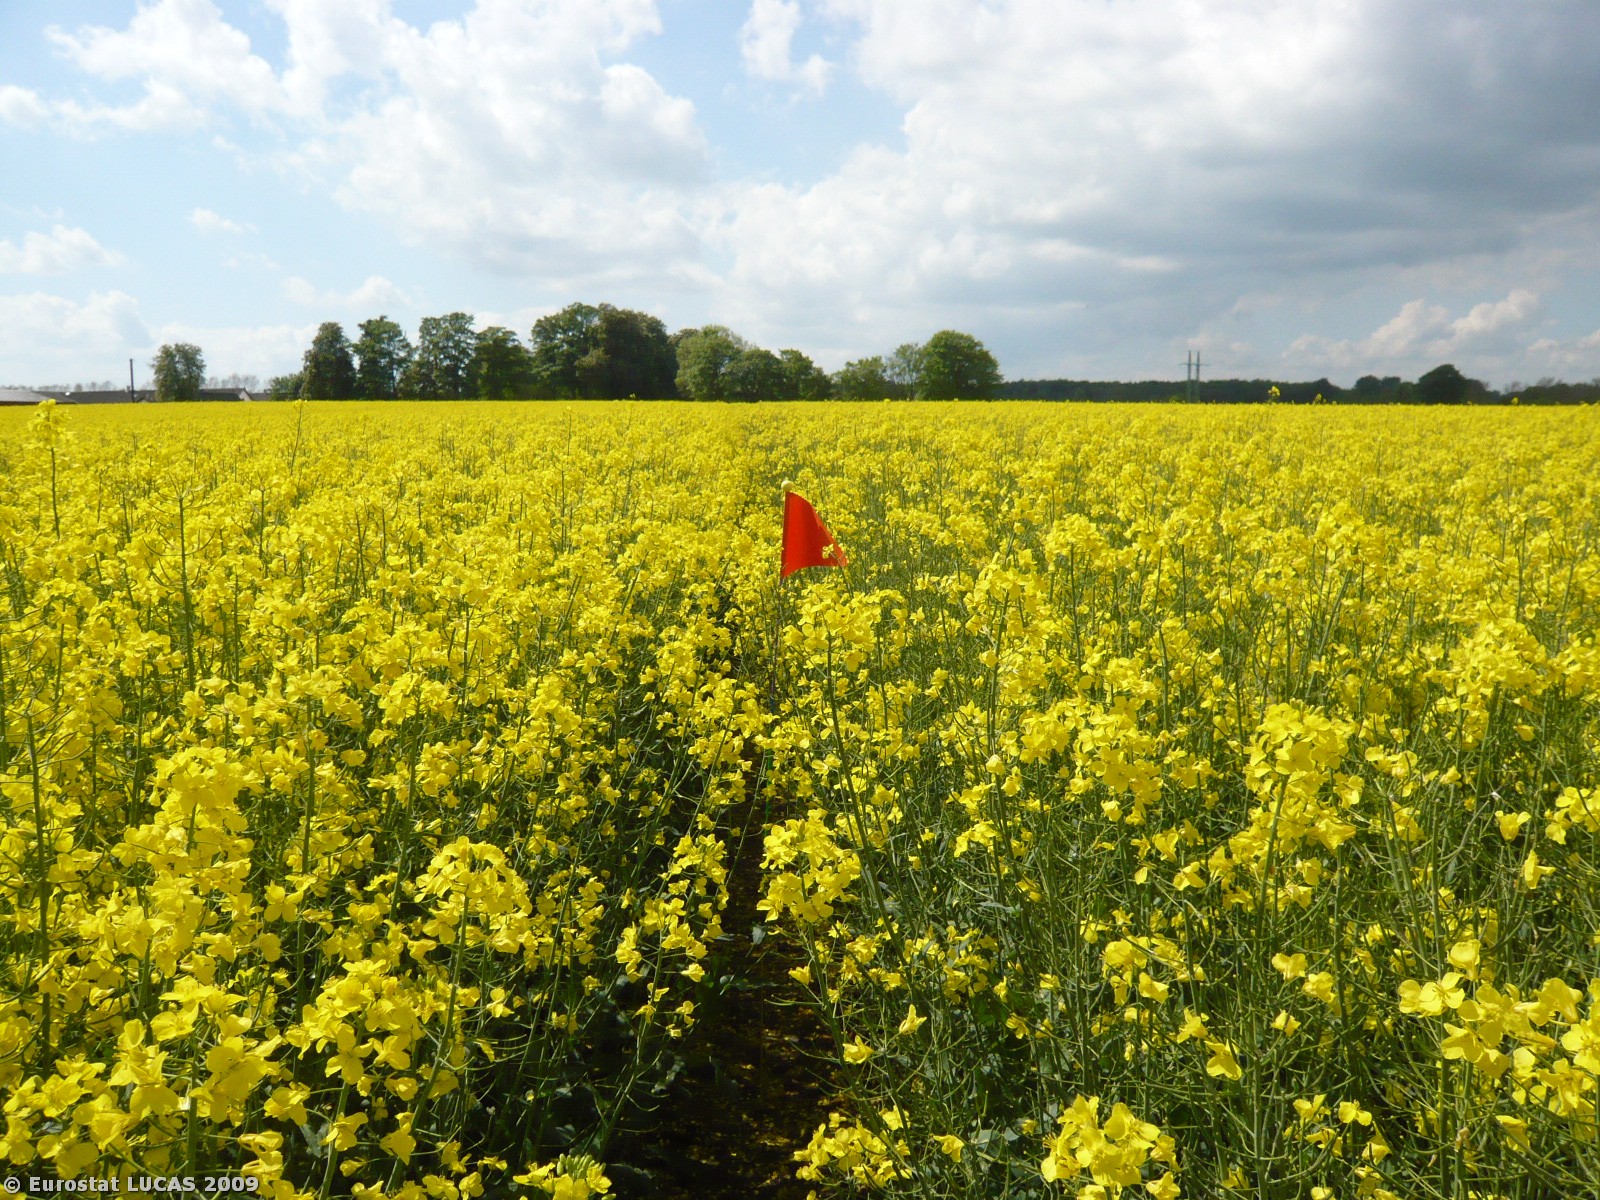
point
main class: Cropland
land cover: Rape and turnip rape
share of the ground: > 75 %
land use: Agriculture (excluding fallow land and kitchen gardens)
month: May
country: DK
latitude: 55.4154
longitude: 12.0993
